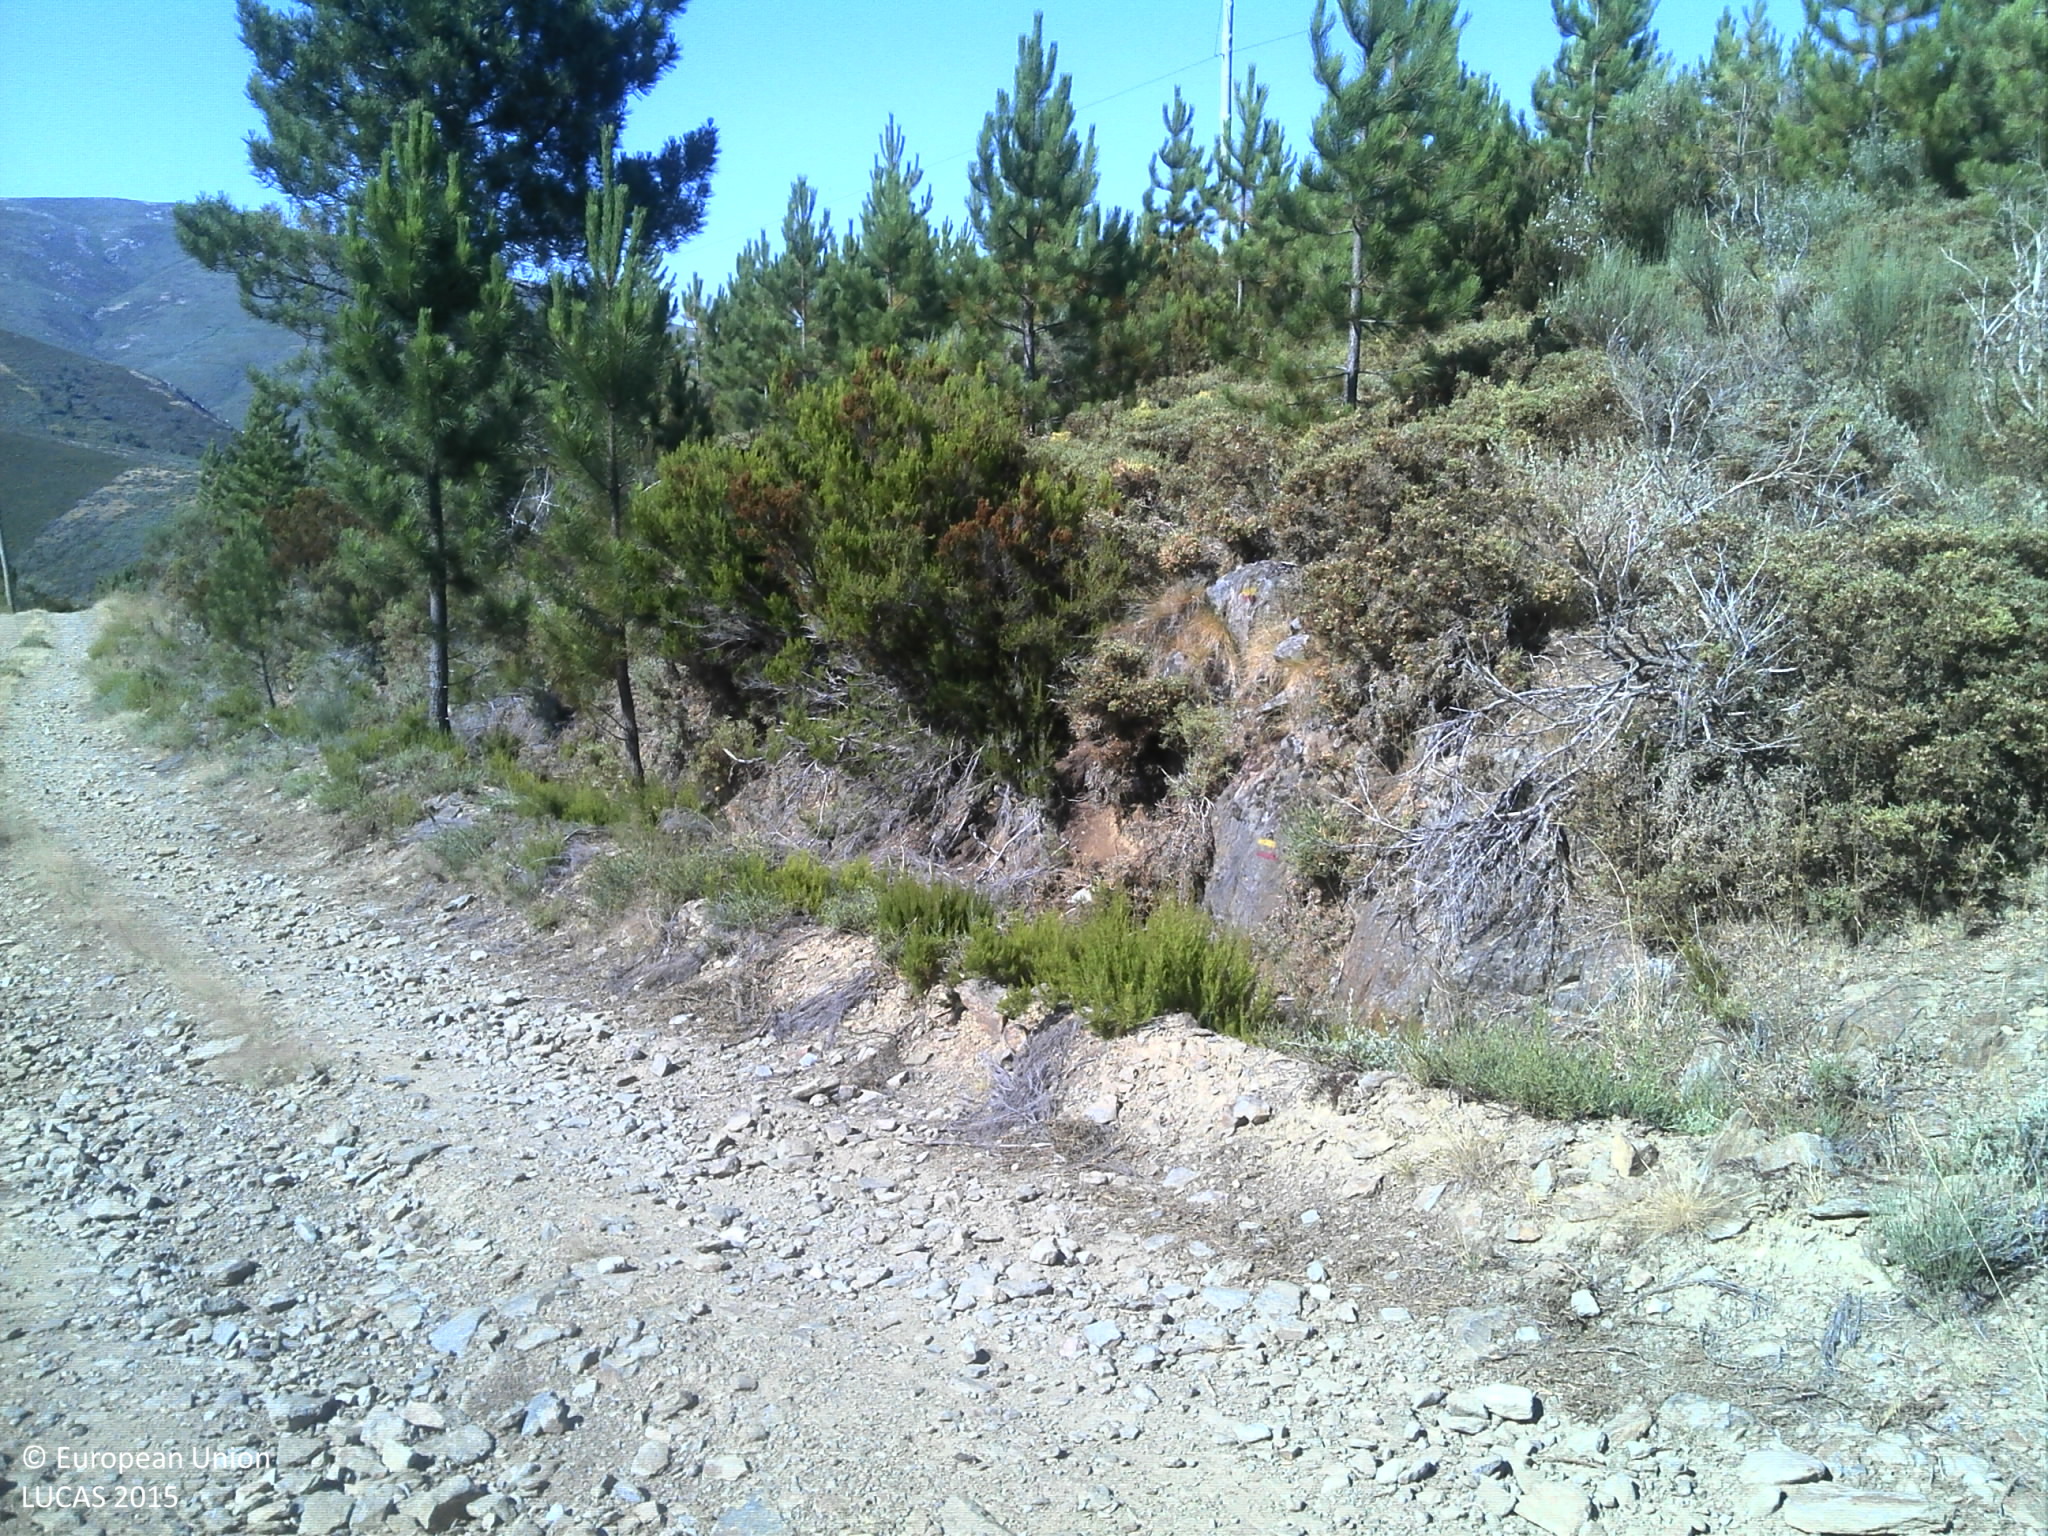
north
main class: Shrubland
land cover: Shrubland with sparse tree cover
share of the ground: 50 - 75 %
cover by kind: shrubs 75 %, unconsolidated bare surface 15 %, coniferous forest trees 5 %
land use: Semi-natural and natural areas not in use
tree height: > 5 m
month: July
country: PT
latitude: 40.4261
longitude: -7.5436
